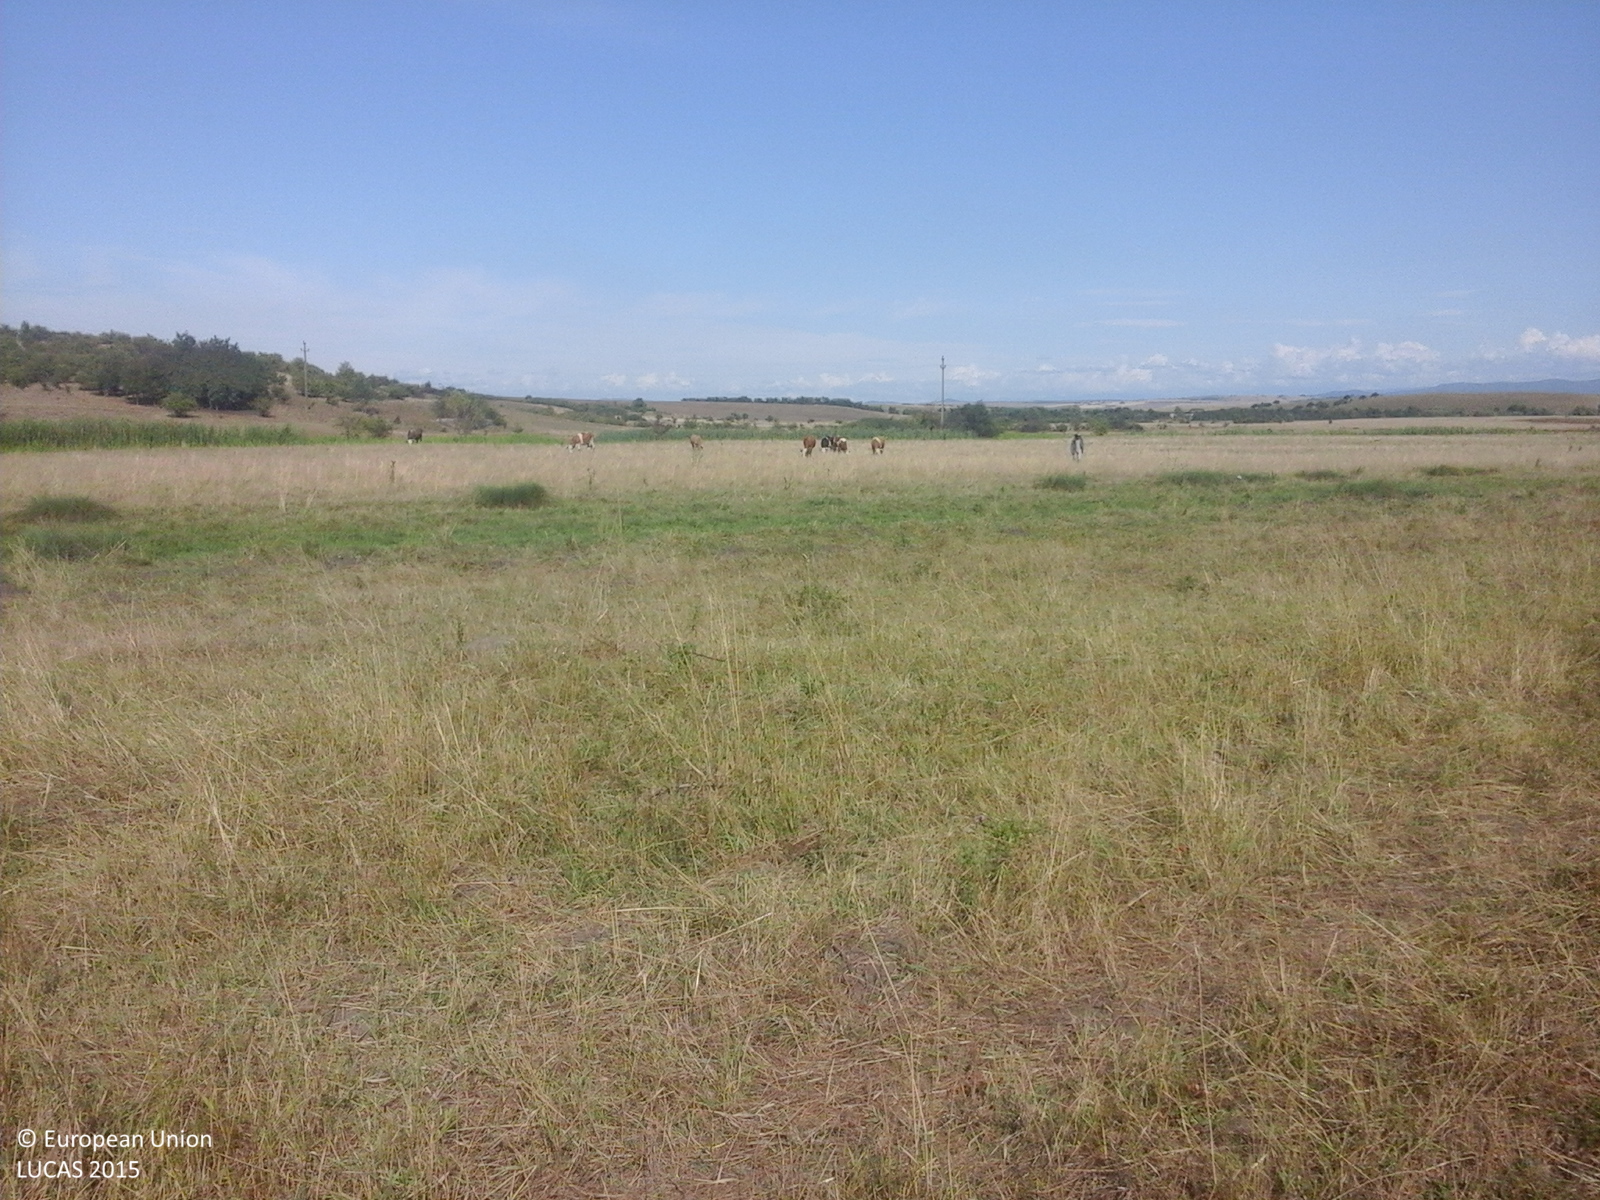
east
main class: Grassland
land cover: Grassland without tree/shrub cover
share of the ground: > 75 %
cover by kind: herbaceous plants 100 %
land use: Agriculture (excluding fallow land and kitchen gardens)
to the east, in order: Grassland without tree/shrub cover; Ditches and canals; Grassland without tree/shrub cover; Electric lines; Grassland without tree/shrub cover; Single bushes/trees; Grassland without tree/shrub cover
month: August
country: RO
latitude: 45.3722
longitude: 21.4333
